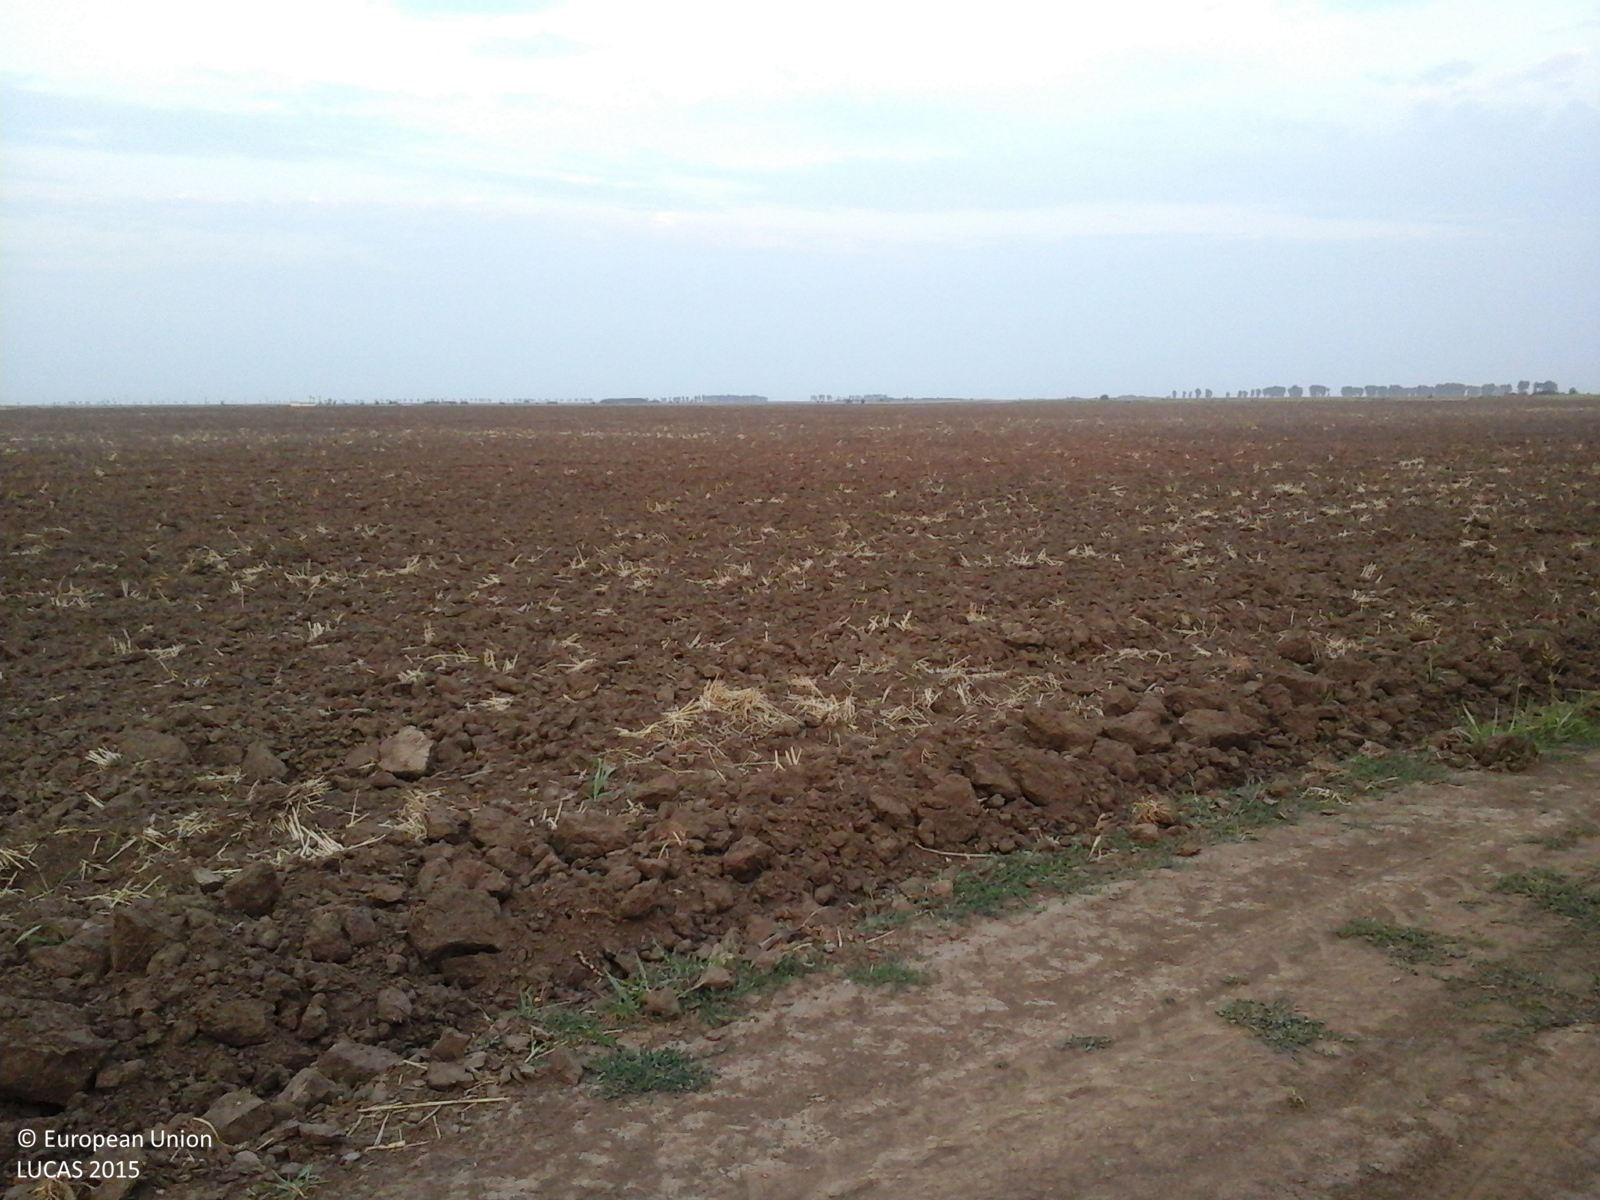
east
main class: Cropland
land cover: Maize
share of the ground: > 75 %
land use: Agriculture (excluding fallow land and kitchen gardens)
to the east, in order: Maize; Grass margins; Tracks; Grass margins; Other bare soil
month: August
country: RO
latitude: 45.0142
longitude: 27.4419
